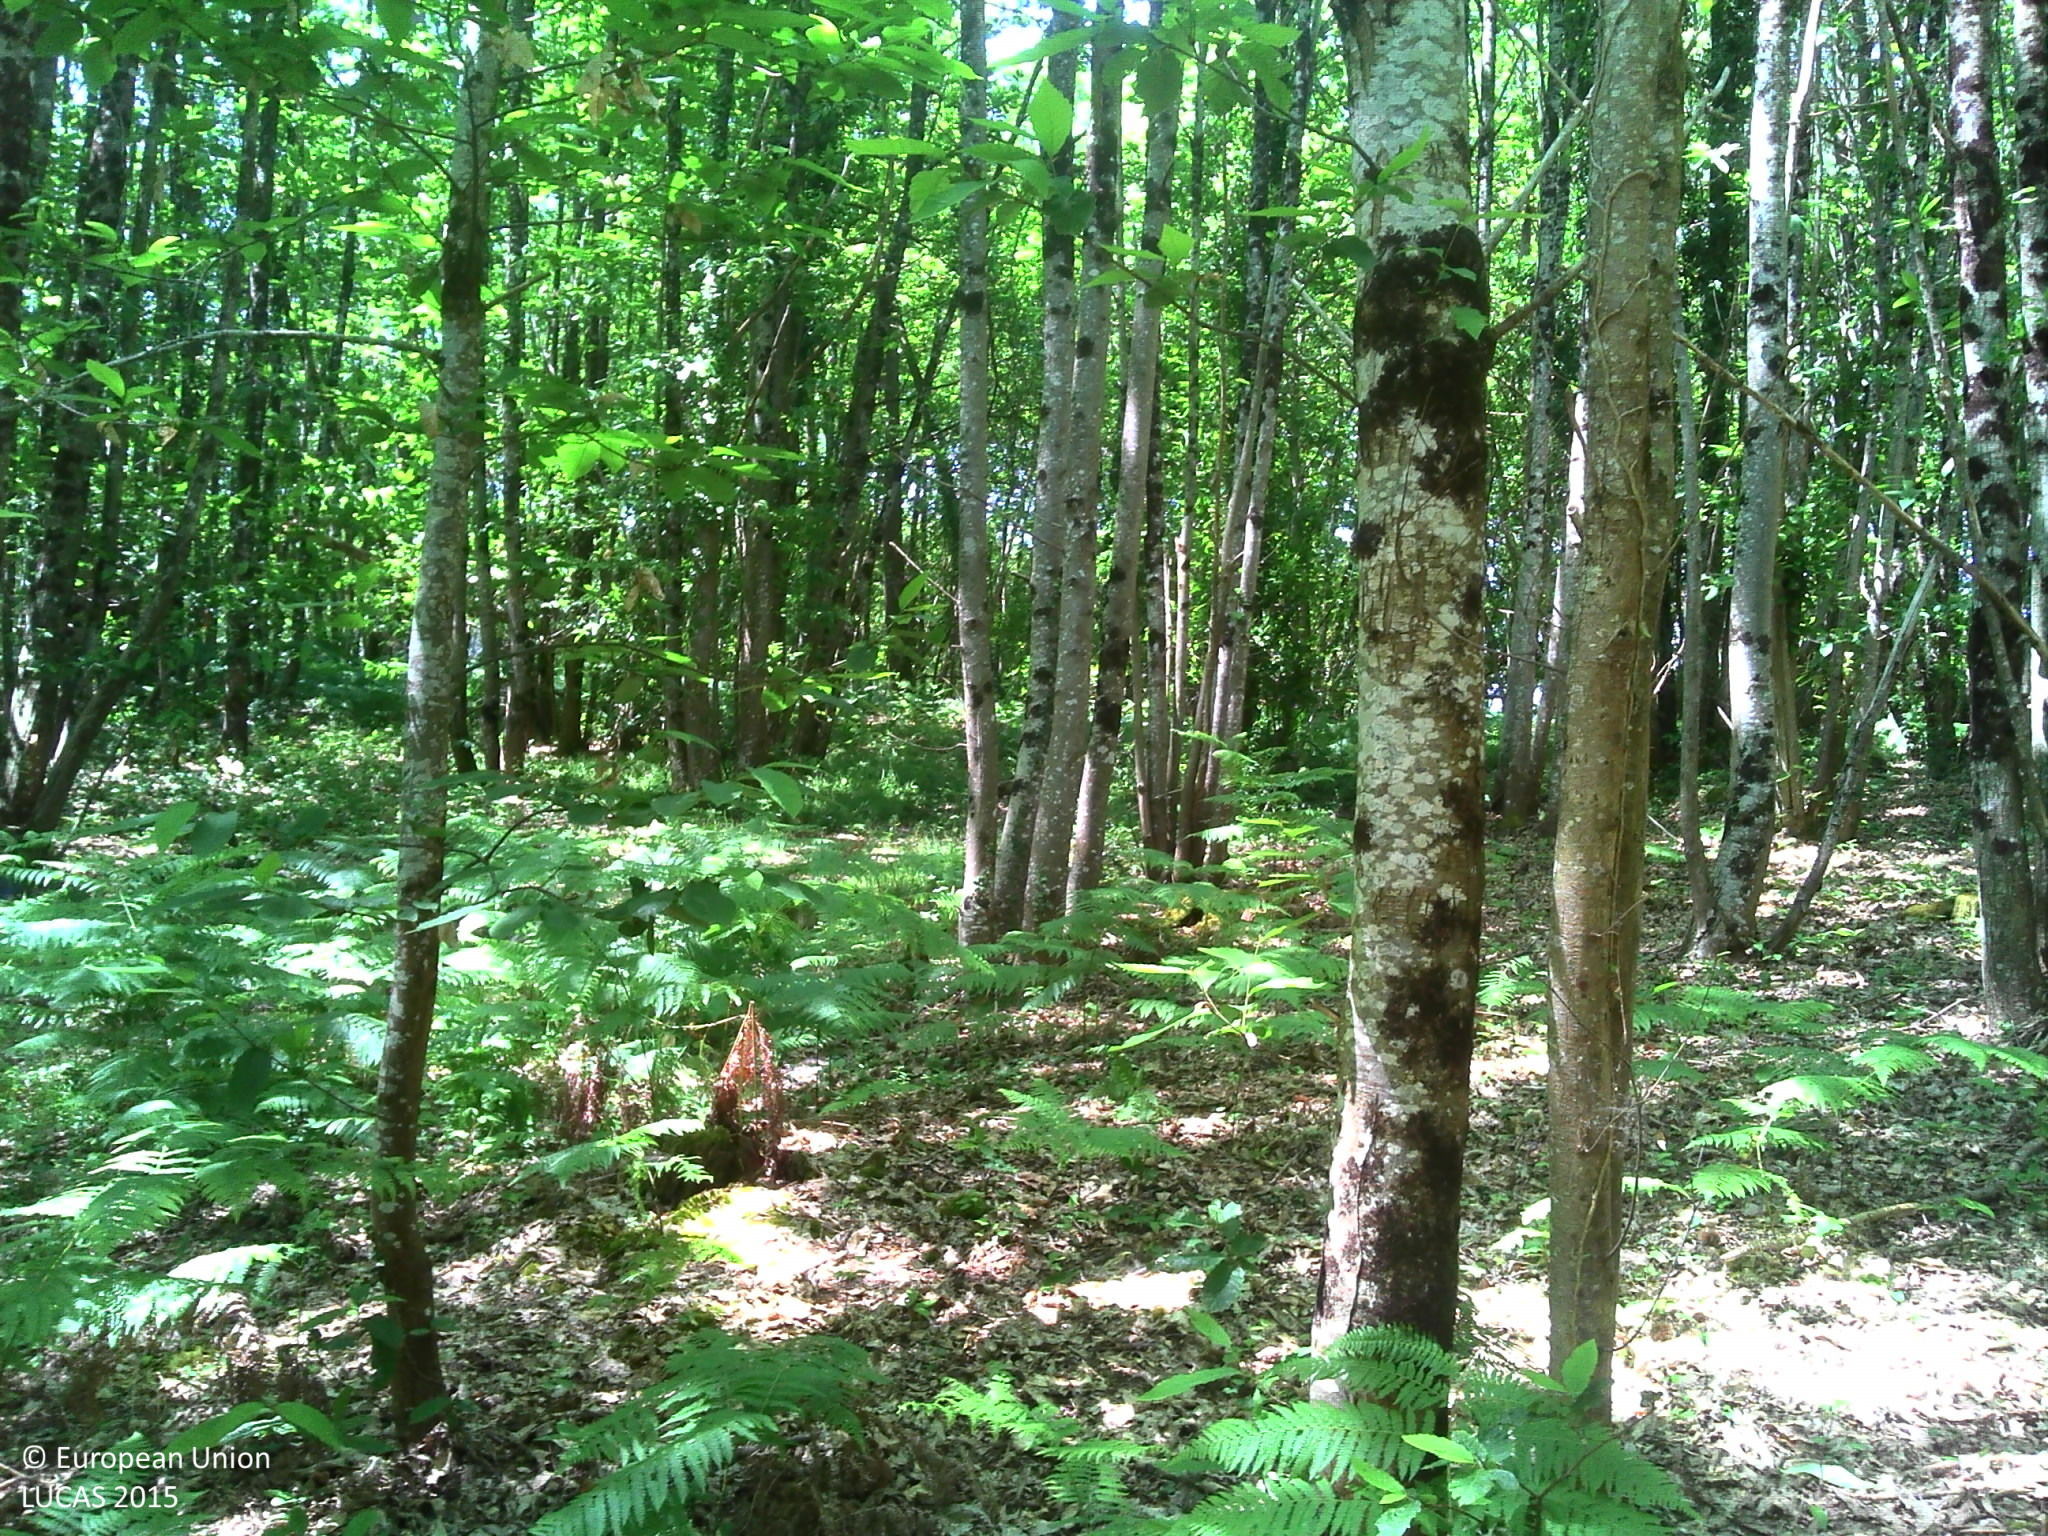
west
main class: Woodland
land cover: Broadleaved woodland
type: mesophytic deciduous forest
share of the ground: > 75 %
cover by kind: broadleaved forest trees 65 %, unconsolidated bare surface 15 %, herbaceous plants 10 %, lichens and mosses 10 %
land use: Forestry
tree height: > 5 m
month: June
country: FR
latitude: 47.3788
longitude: 0.1081
